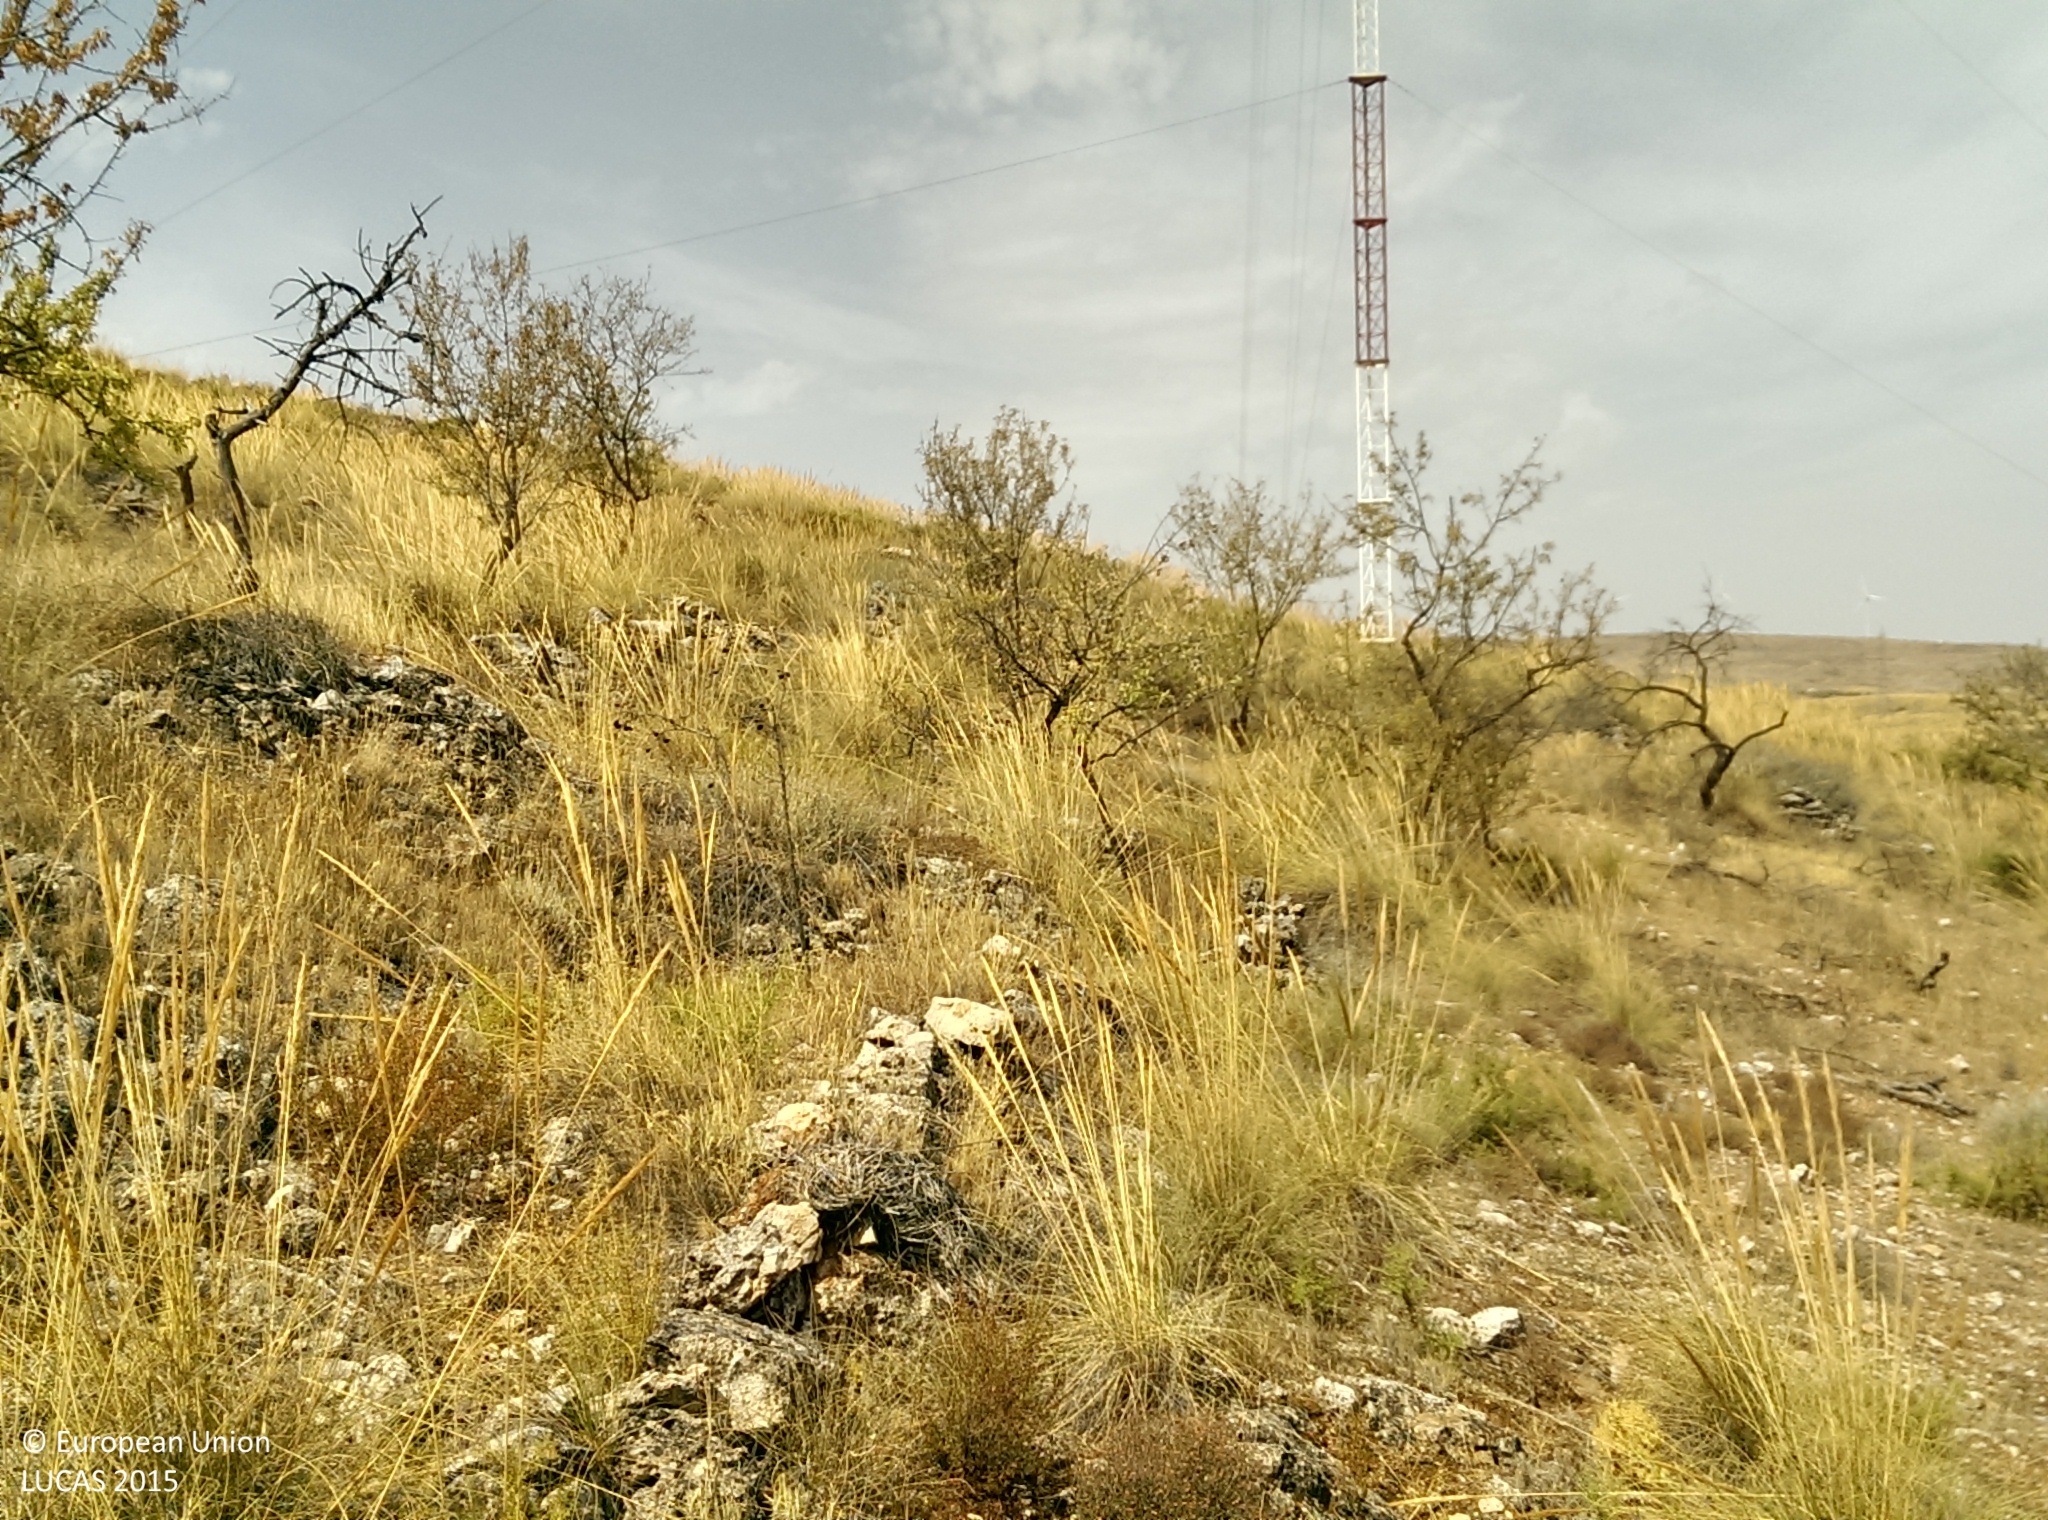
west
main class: Cropland
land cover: Nuts trees
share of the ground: 10 - 25 %
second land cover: Spontaneously vegetated surfaces
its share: 25 - 50 %
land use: Agriculture (excluding fallow land and kitchen gardens)
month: August
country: ES
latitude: 36.9986
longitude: -3.6394
